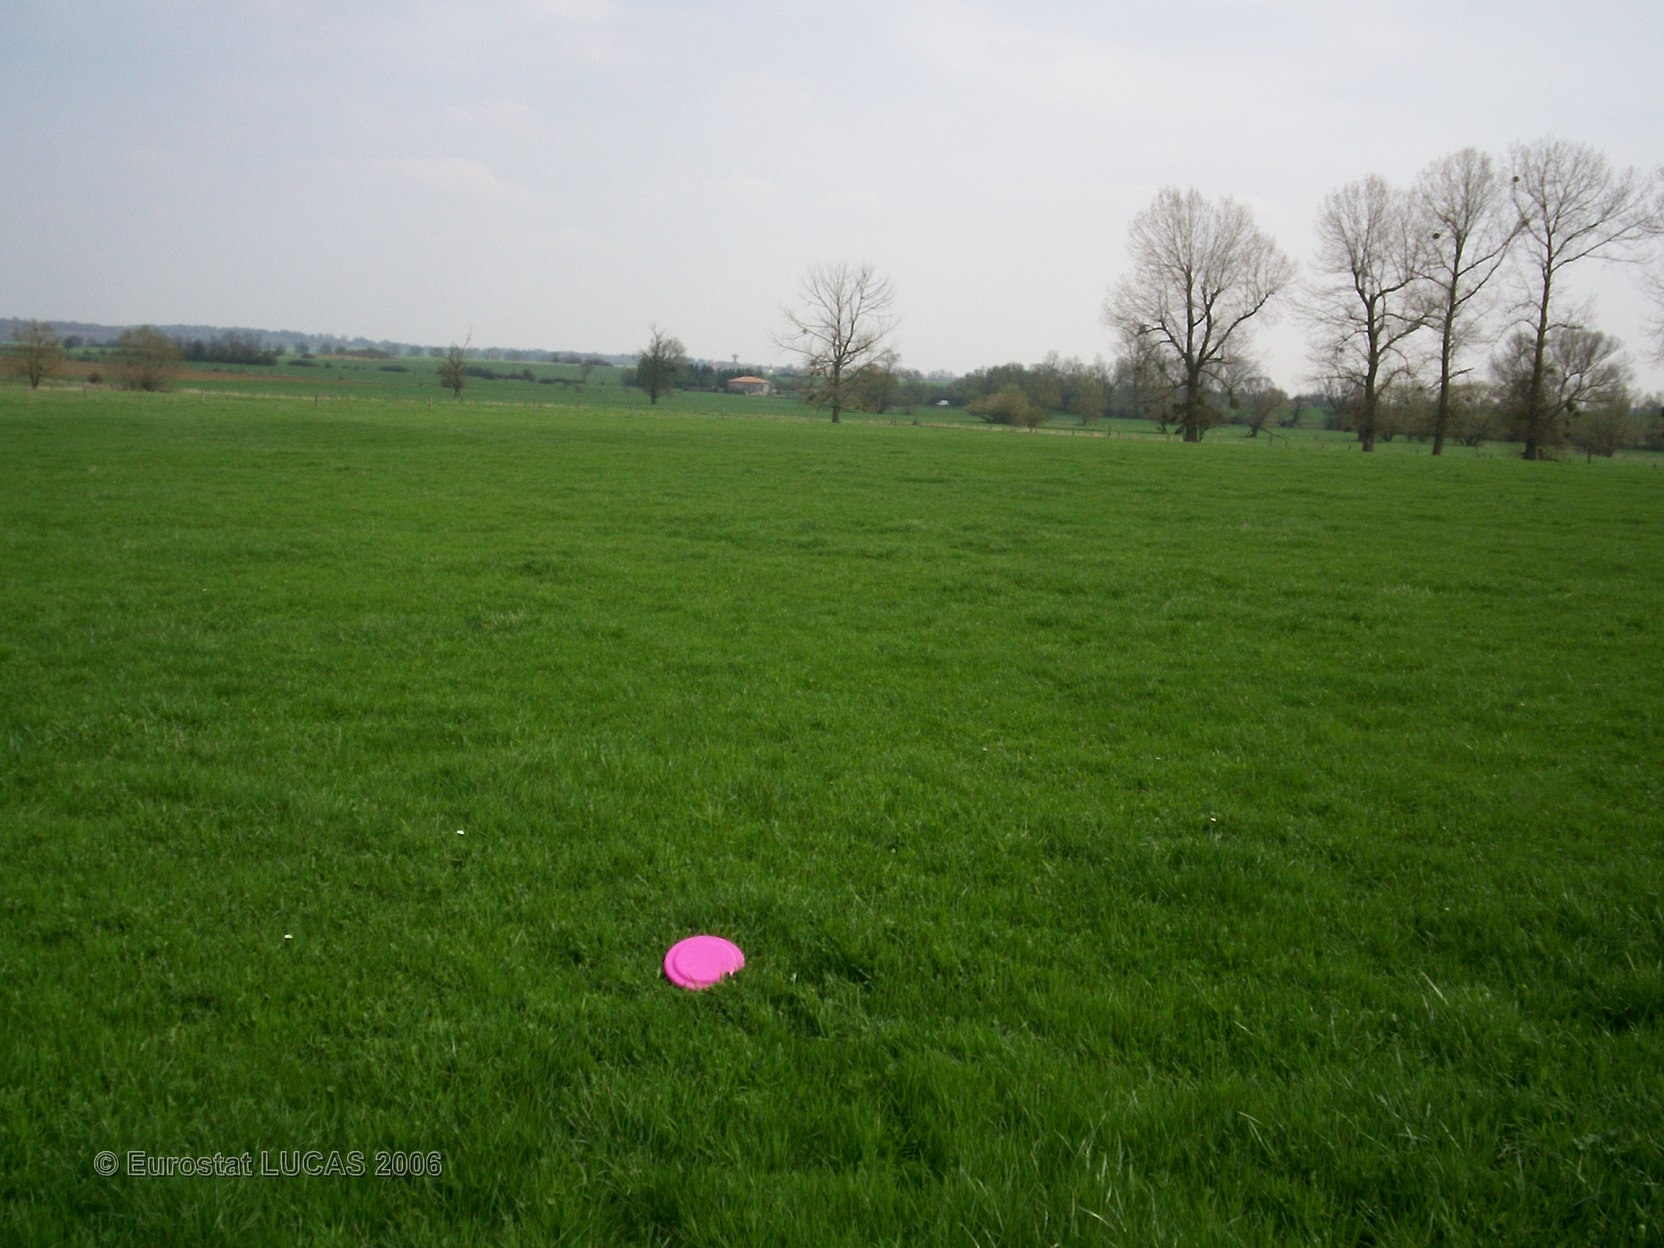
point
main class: Grassland
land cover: Grassland without tree/shrub cover
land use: Agriculture (excluding fallow land and kitchen gardens)
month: April
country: FR
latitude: 48.7780
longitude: 5.9035
